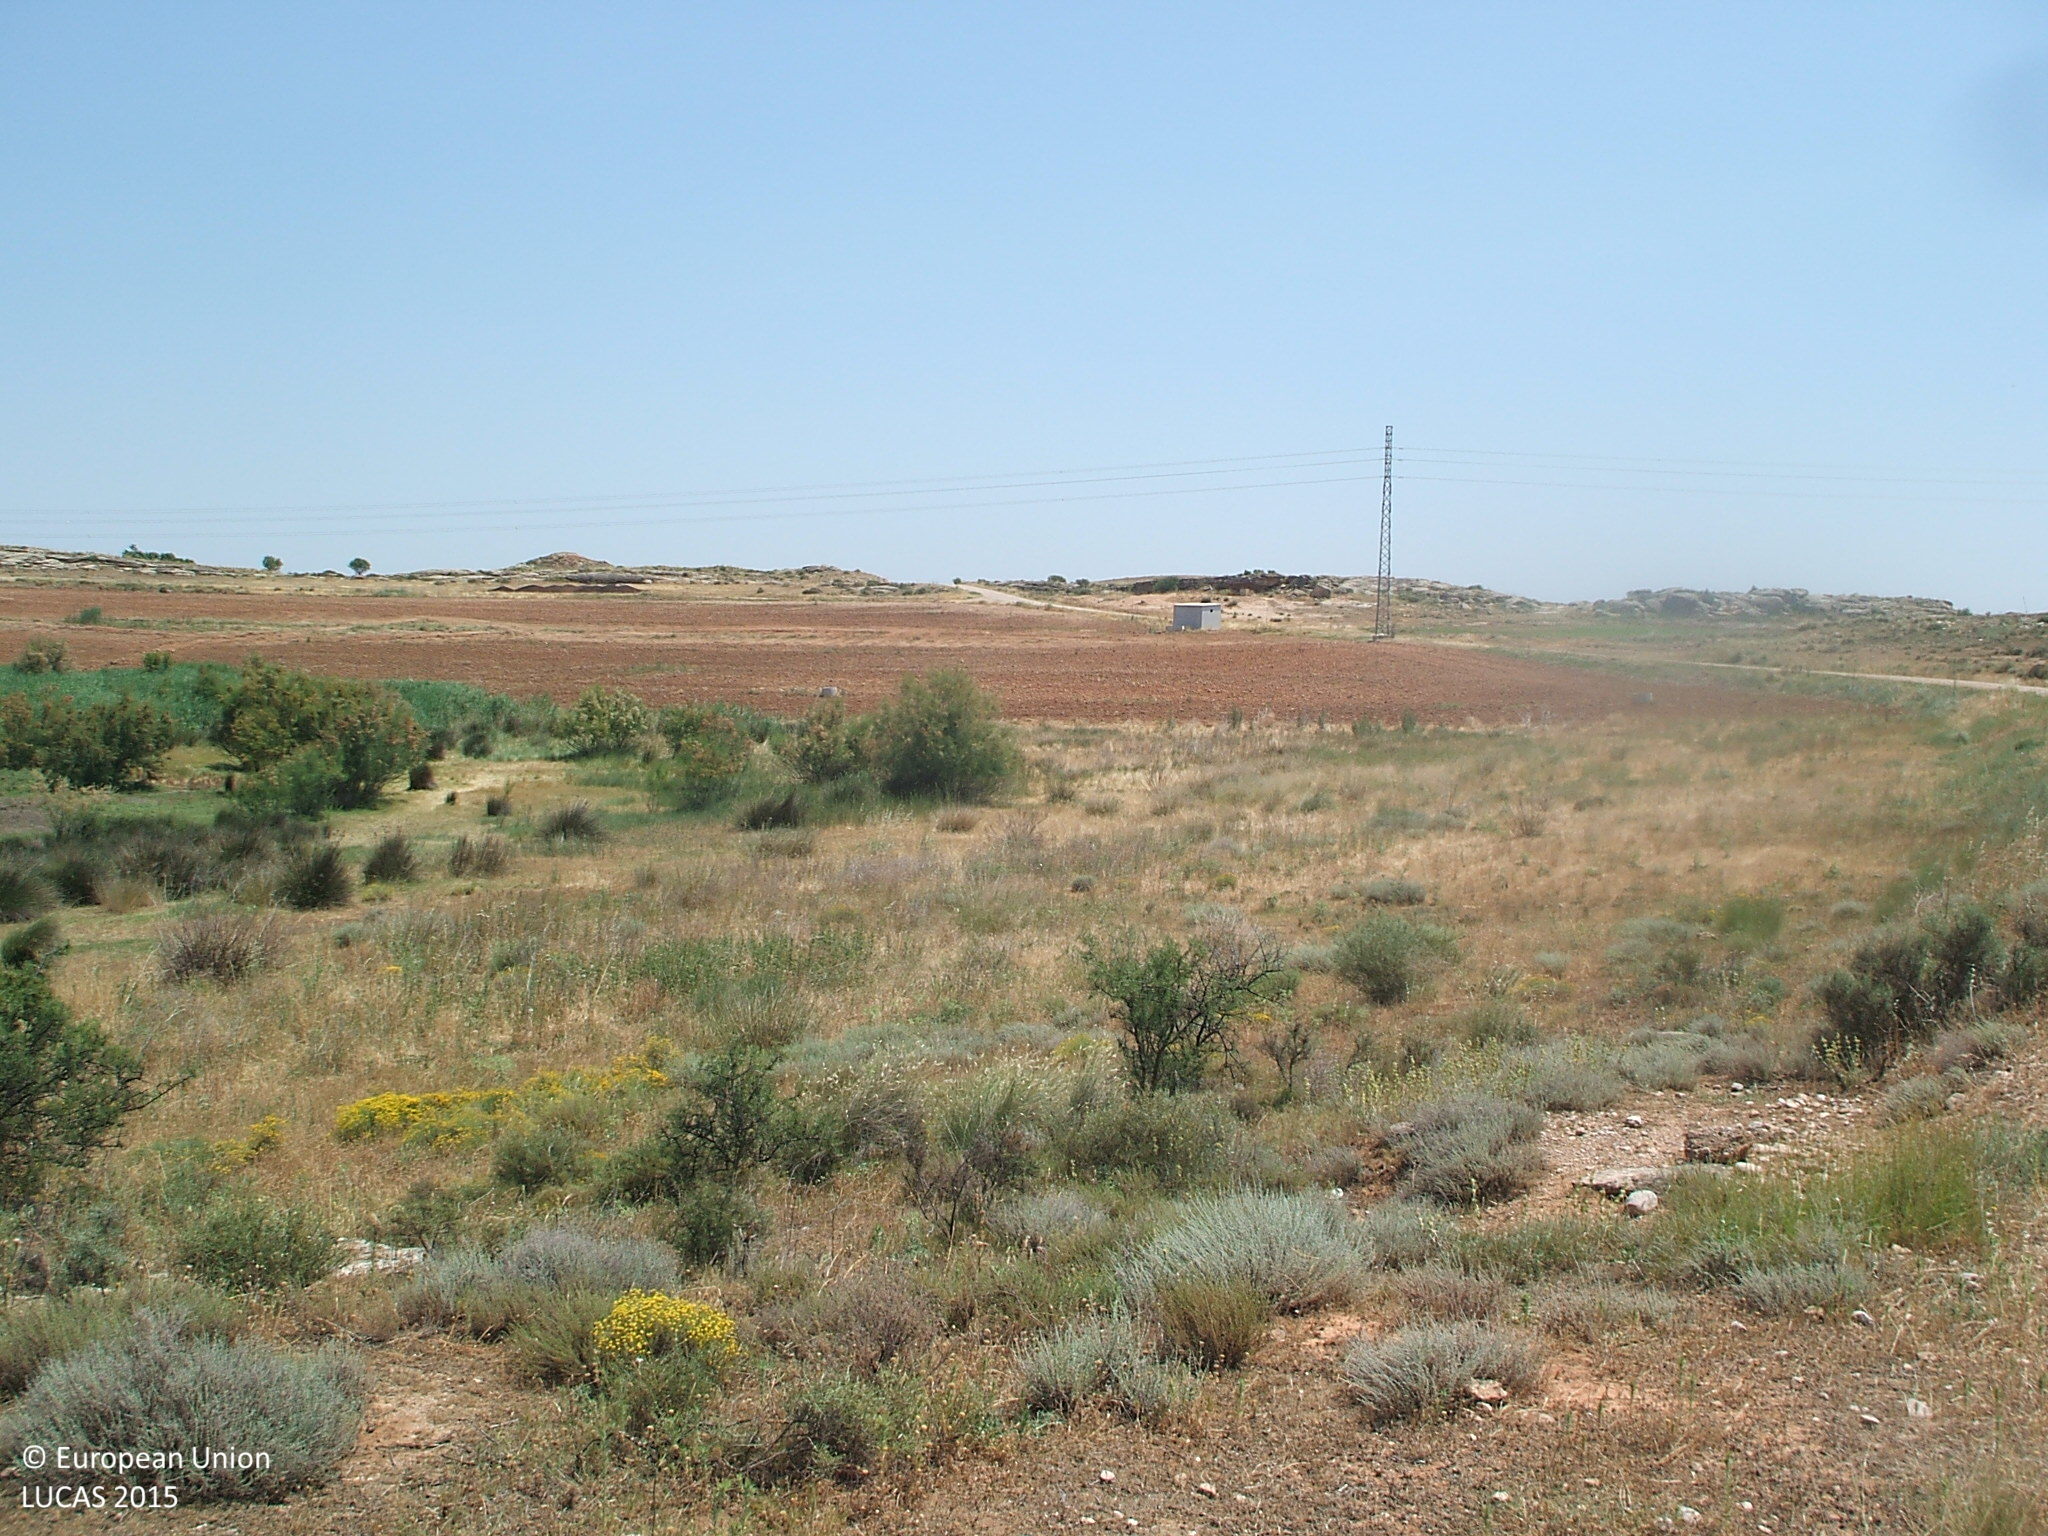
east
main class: Shrubland
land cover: Shrubland without tree cover
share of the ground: > 75 %
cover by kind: shrubs 90 %, herbaceous plants 10 %
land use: Semi-natural and natural areas not in use
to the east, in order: Shrubland without tree cover; Grassland without tree/shrub cover; Other bare soil; Electric lines; Grass margins; Tracks; Grass margins; Sunflower; Grassland without tree/shrub cover; Tracks
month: June
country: ES
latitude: 41.0476
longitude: -0.1836
